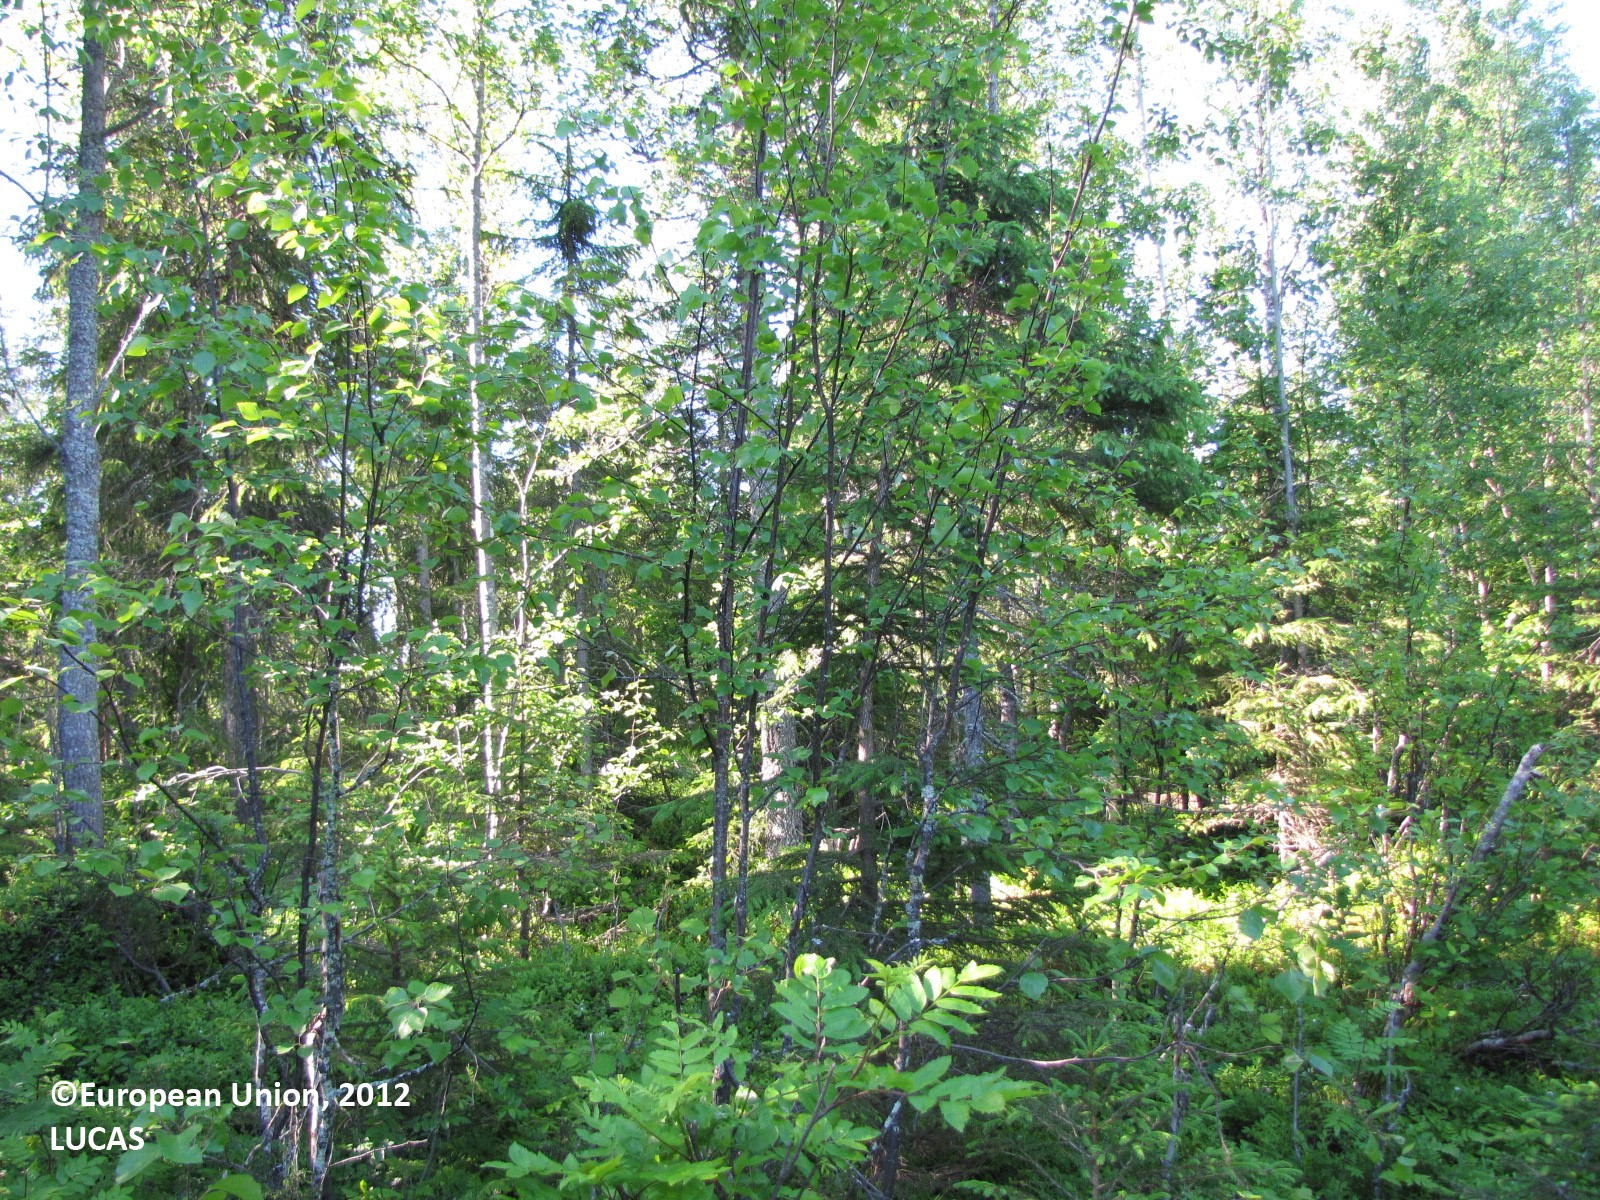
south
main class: Woodland
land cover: Spruce dominated mixed woodland
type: boreal forest
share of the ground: 25 - 50 %
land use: Forestry
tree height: > 5 m
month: July
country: FI
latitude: 66.1020
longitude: 24.1351
